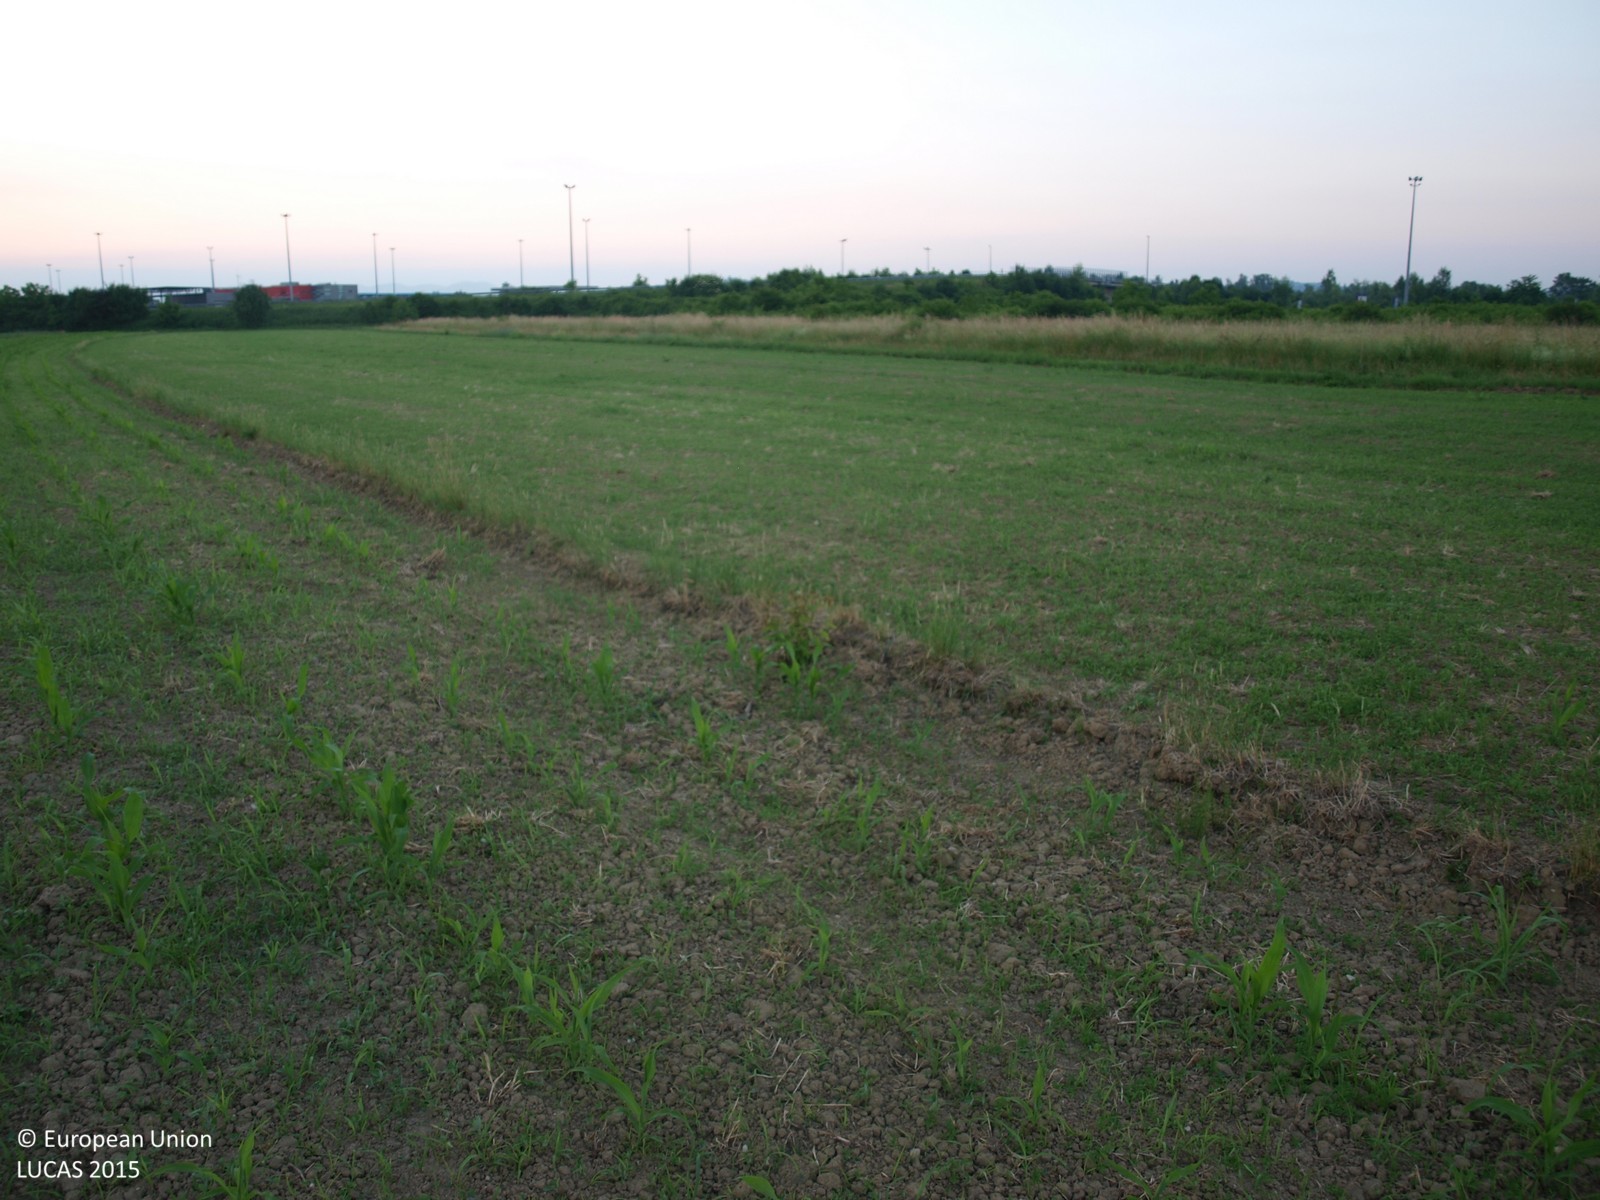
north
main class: Cropland
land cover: Maize
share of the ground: 10 - 25 %
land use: Agriculture (excluding fallow land and kitchen gardens)
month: June
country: HR
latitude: 45.8380
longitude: 15.7010
